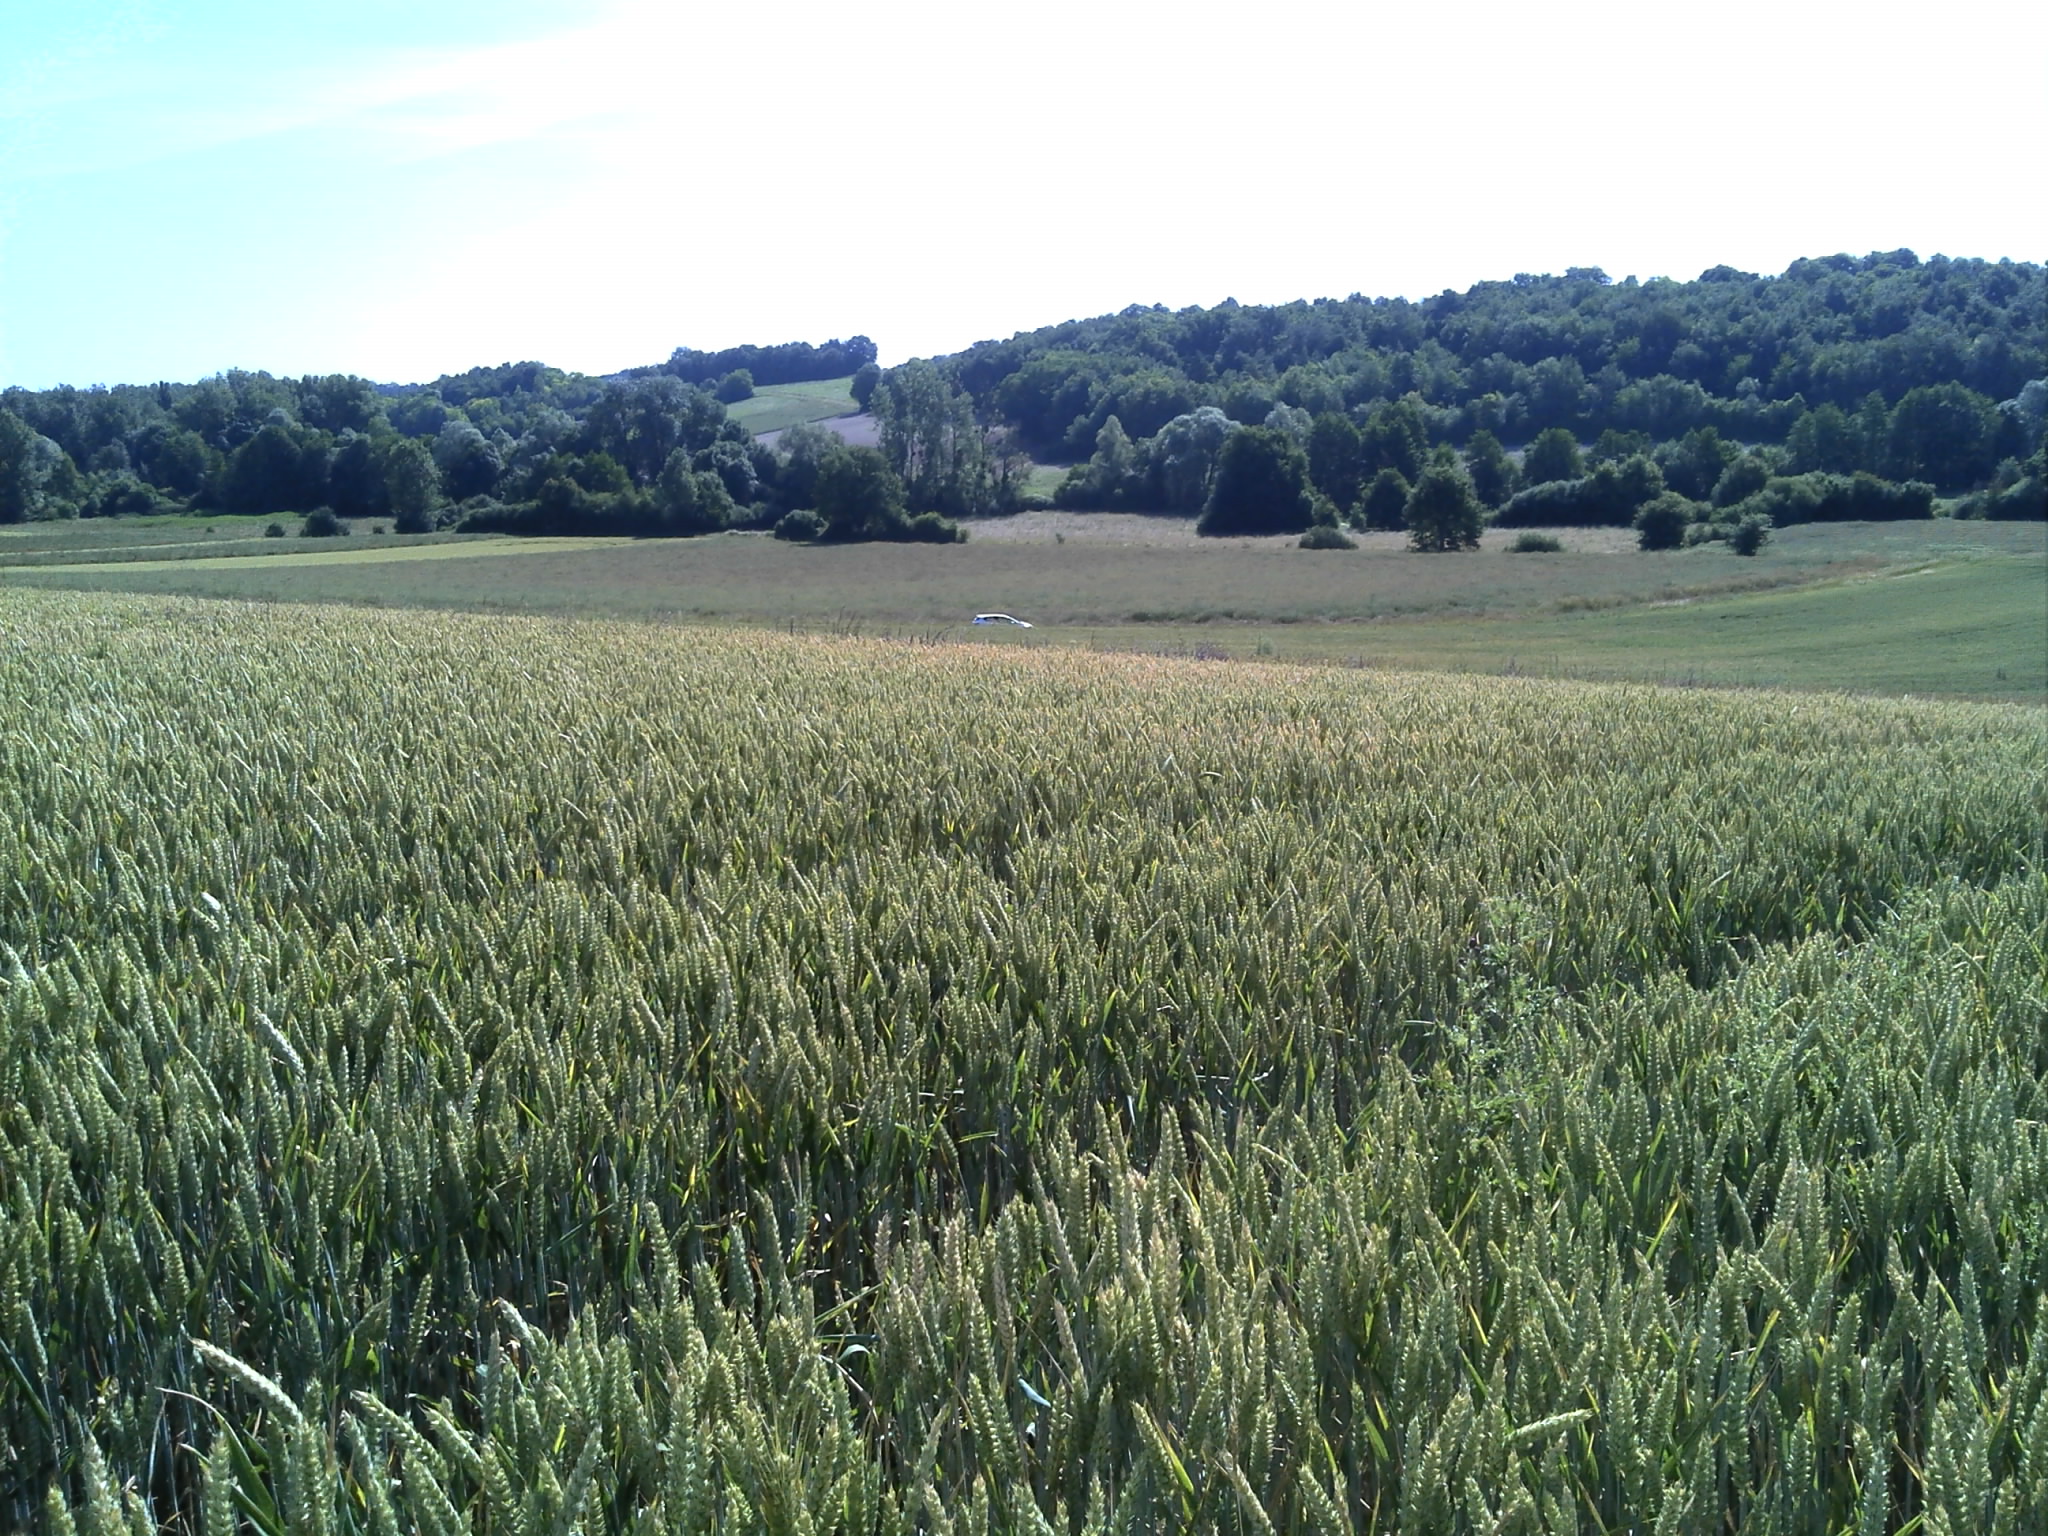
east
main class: Cropland
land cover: Common wheat
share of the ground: > 75 %
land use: Agriculture (excluding fallow land and kitchen gardens)
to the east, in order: Common wheat; Grass margins; Tracks; Grass margins; Rape and turnip rape; Grass margins; Tracks; Grass margins; Fences; Grassland with sparse tree/shrub cover
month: June
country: FR
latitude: 47.2008
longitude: 1.4195
